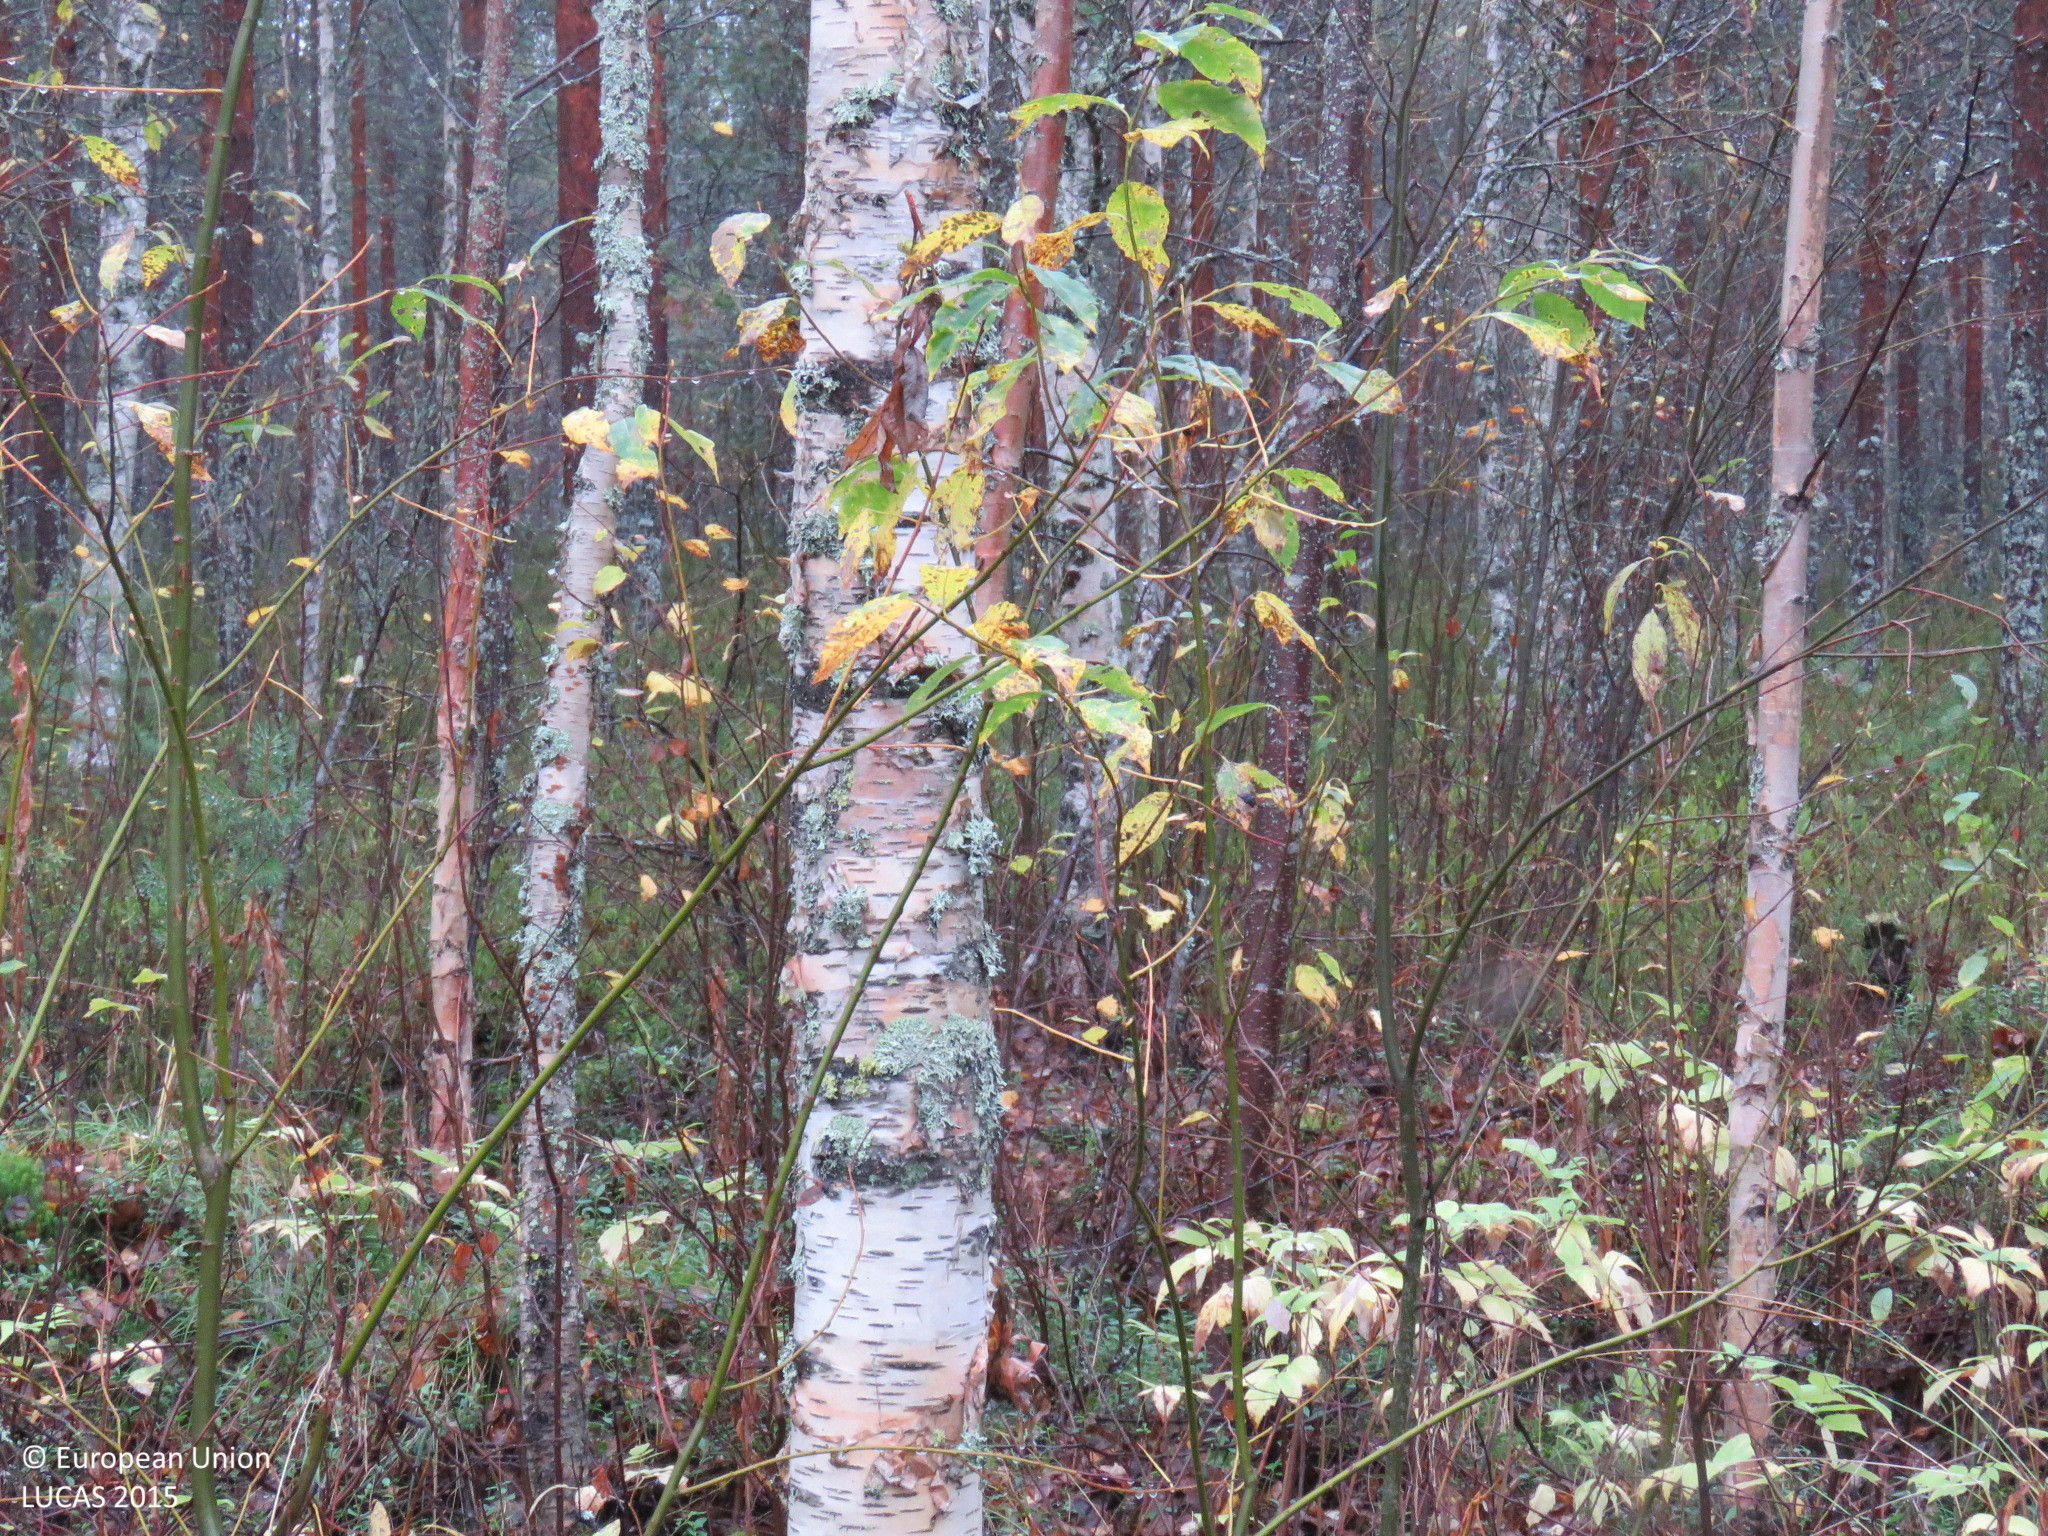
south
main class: Woodland
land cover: Broadleaved woodland
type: non-riverine alder, birch or aspen forest
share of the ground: > 75 %
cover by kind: broadleaved forest trees 90 %, shrubs 5 %, herbaceous plants 5 %
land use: Forestry
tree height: > 5 m
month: September
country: FI
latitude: 65.3184
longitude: 27.2736
